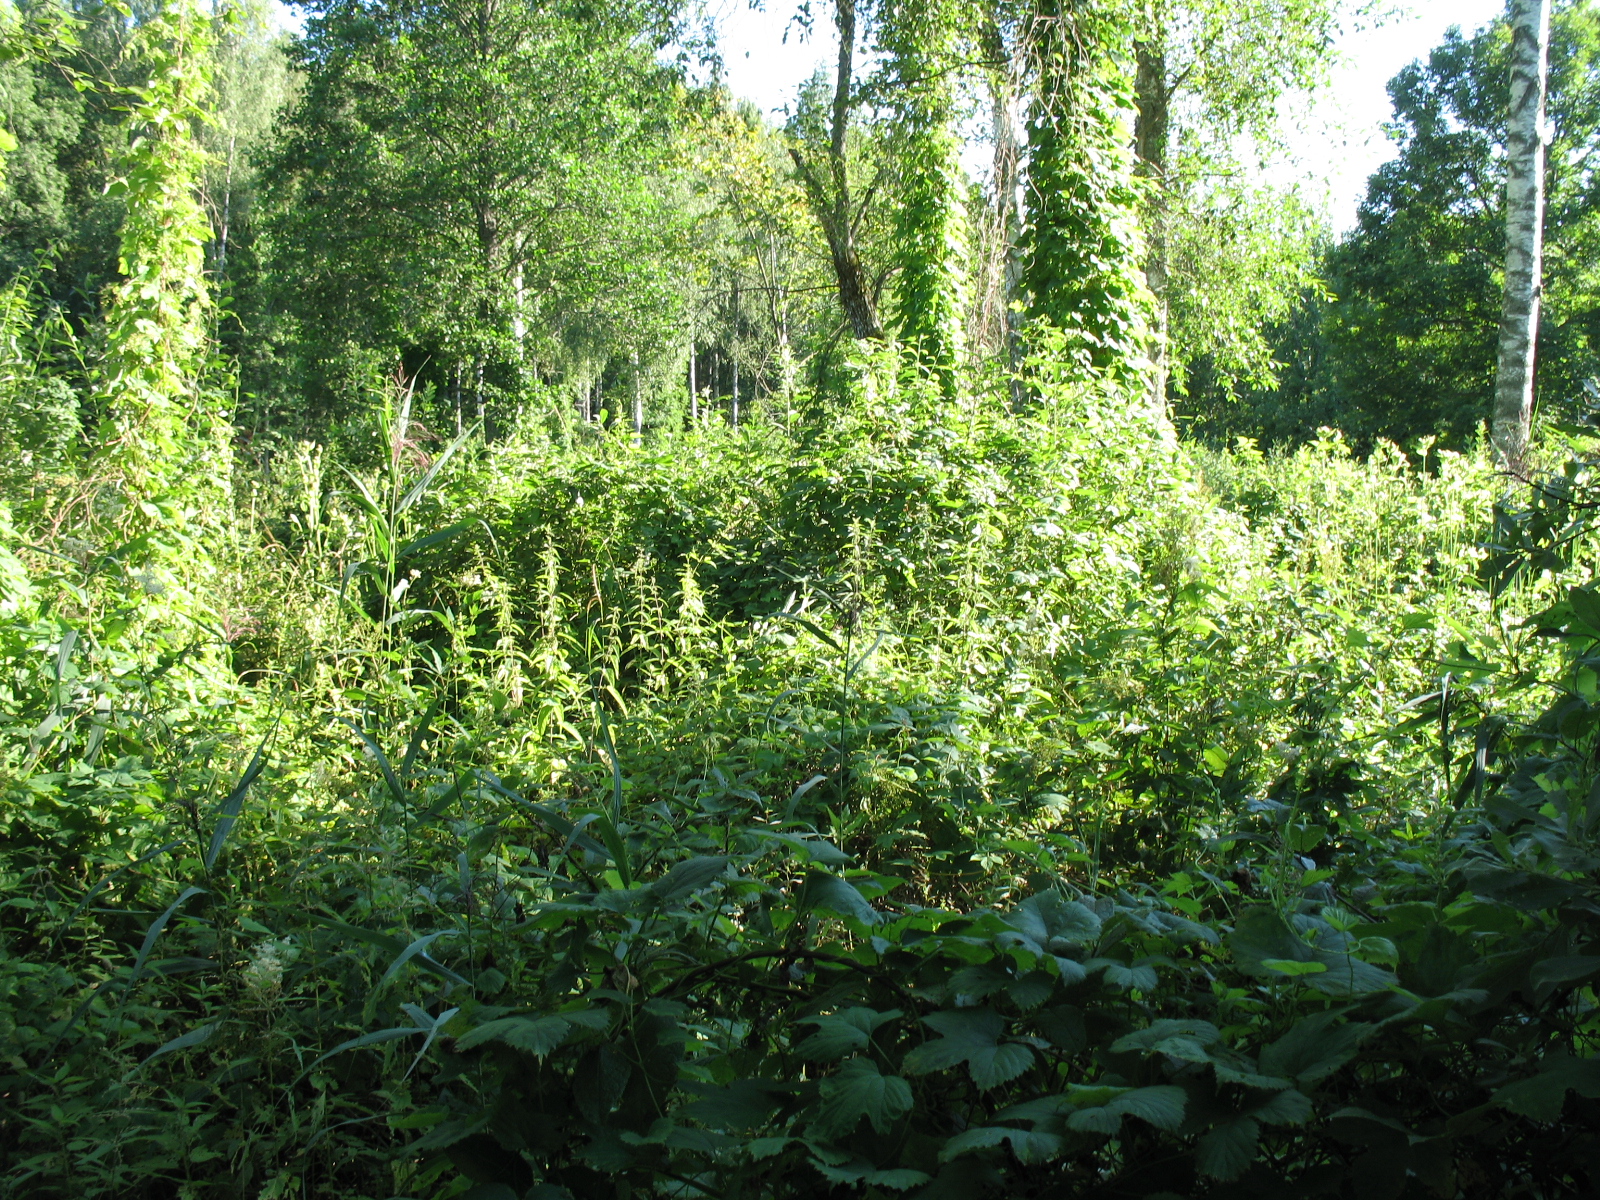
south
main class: Woodland
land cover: Broadleaved woodland
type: mire and swamp forests
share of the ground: 25 - 50 %
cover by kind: broadleaved forest trees 40 %, shrubs 30 %, herbaceous plants 30 %
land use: Forestry
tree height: > 5 m
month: August
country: LV
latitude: 56.4813
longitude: 25.2303
